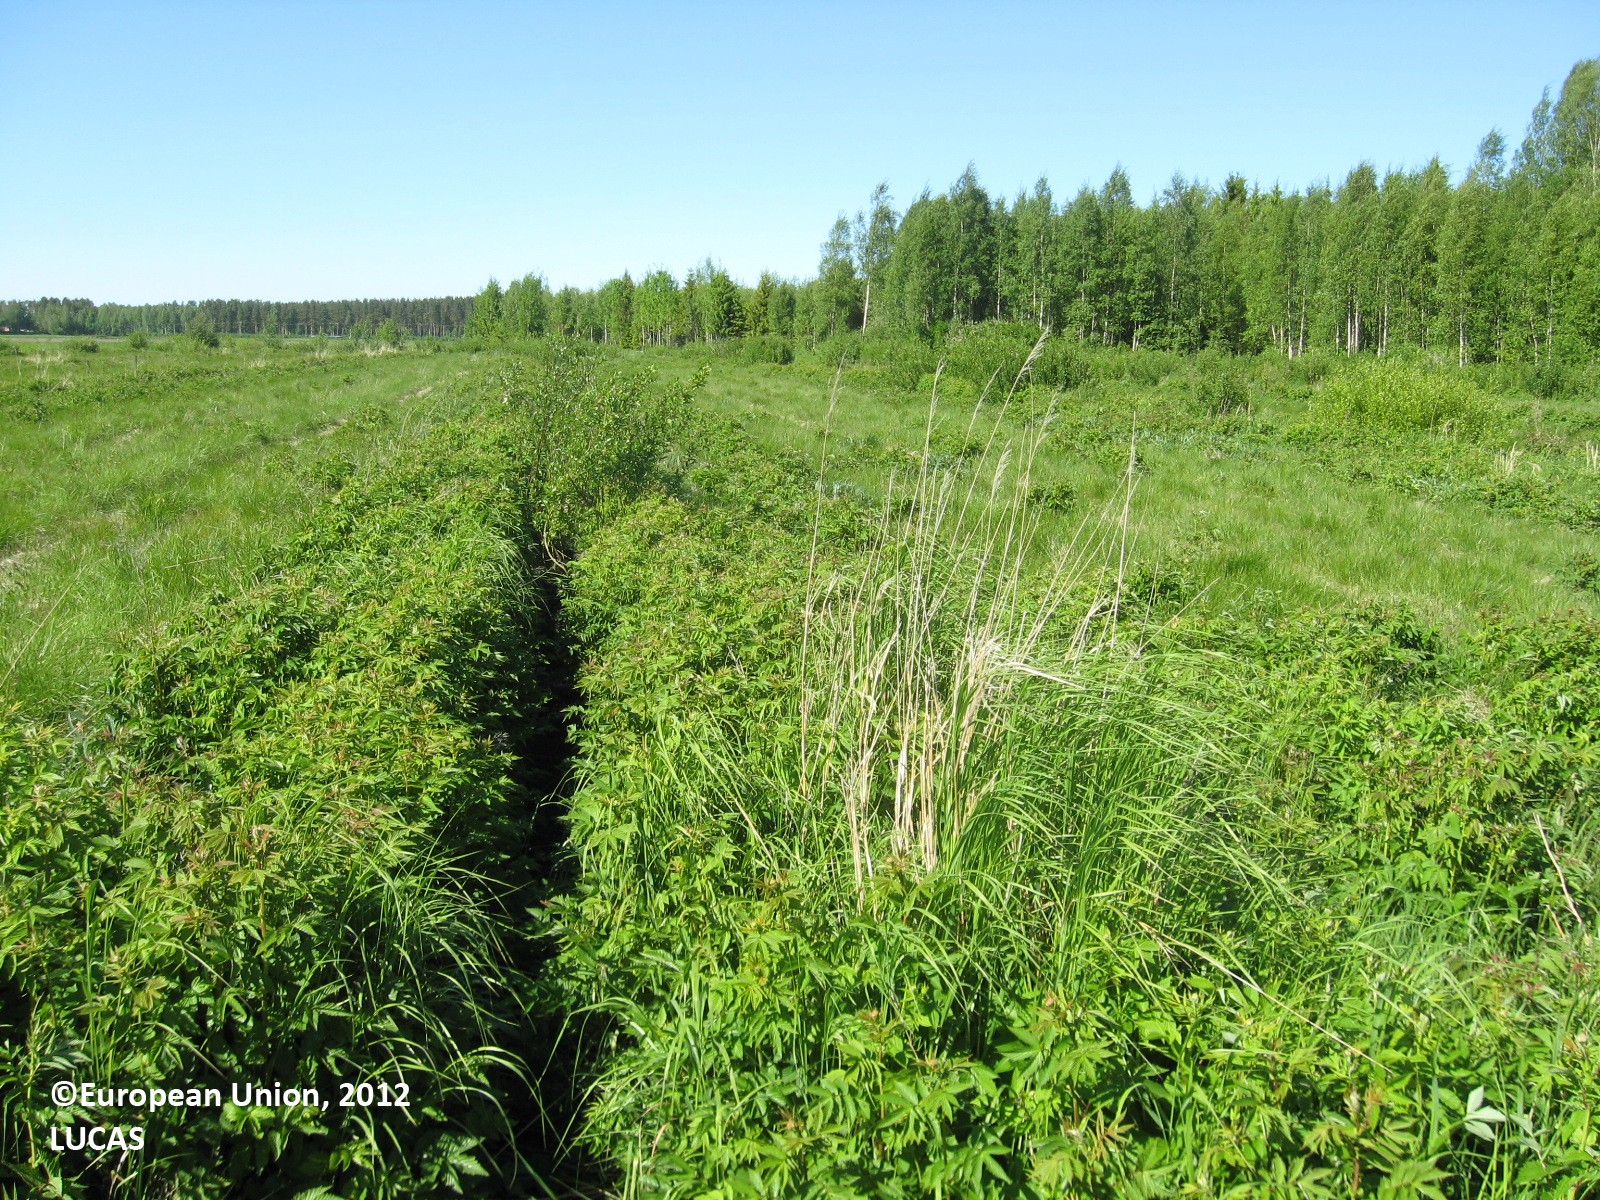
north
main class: Grassland
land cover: Grassland without tree/shrub cover
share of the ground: > 75 %
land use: Agriculture (excluding fallow land and kitchen gardens)
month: June
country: FI
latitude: 63.2942
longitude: 22.7573
